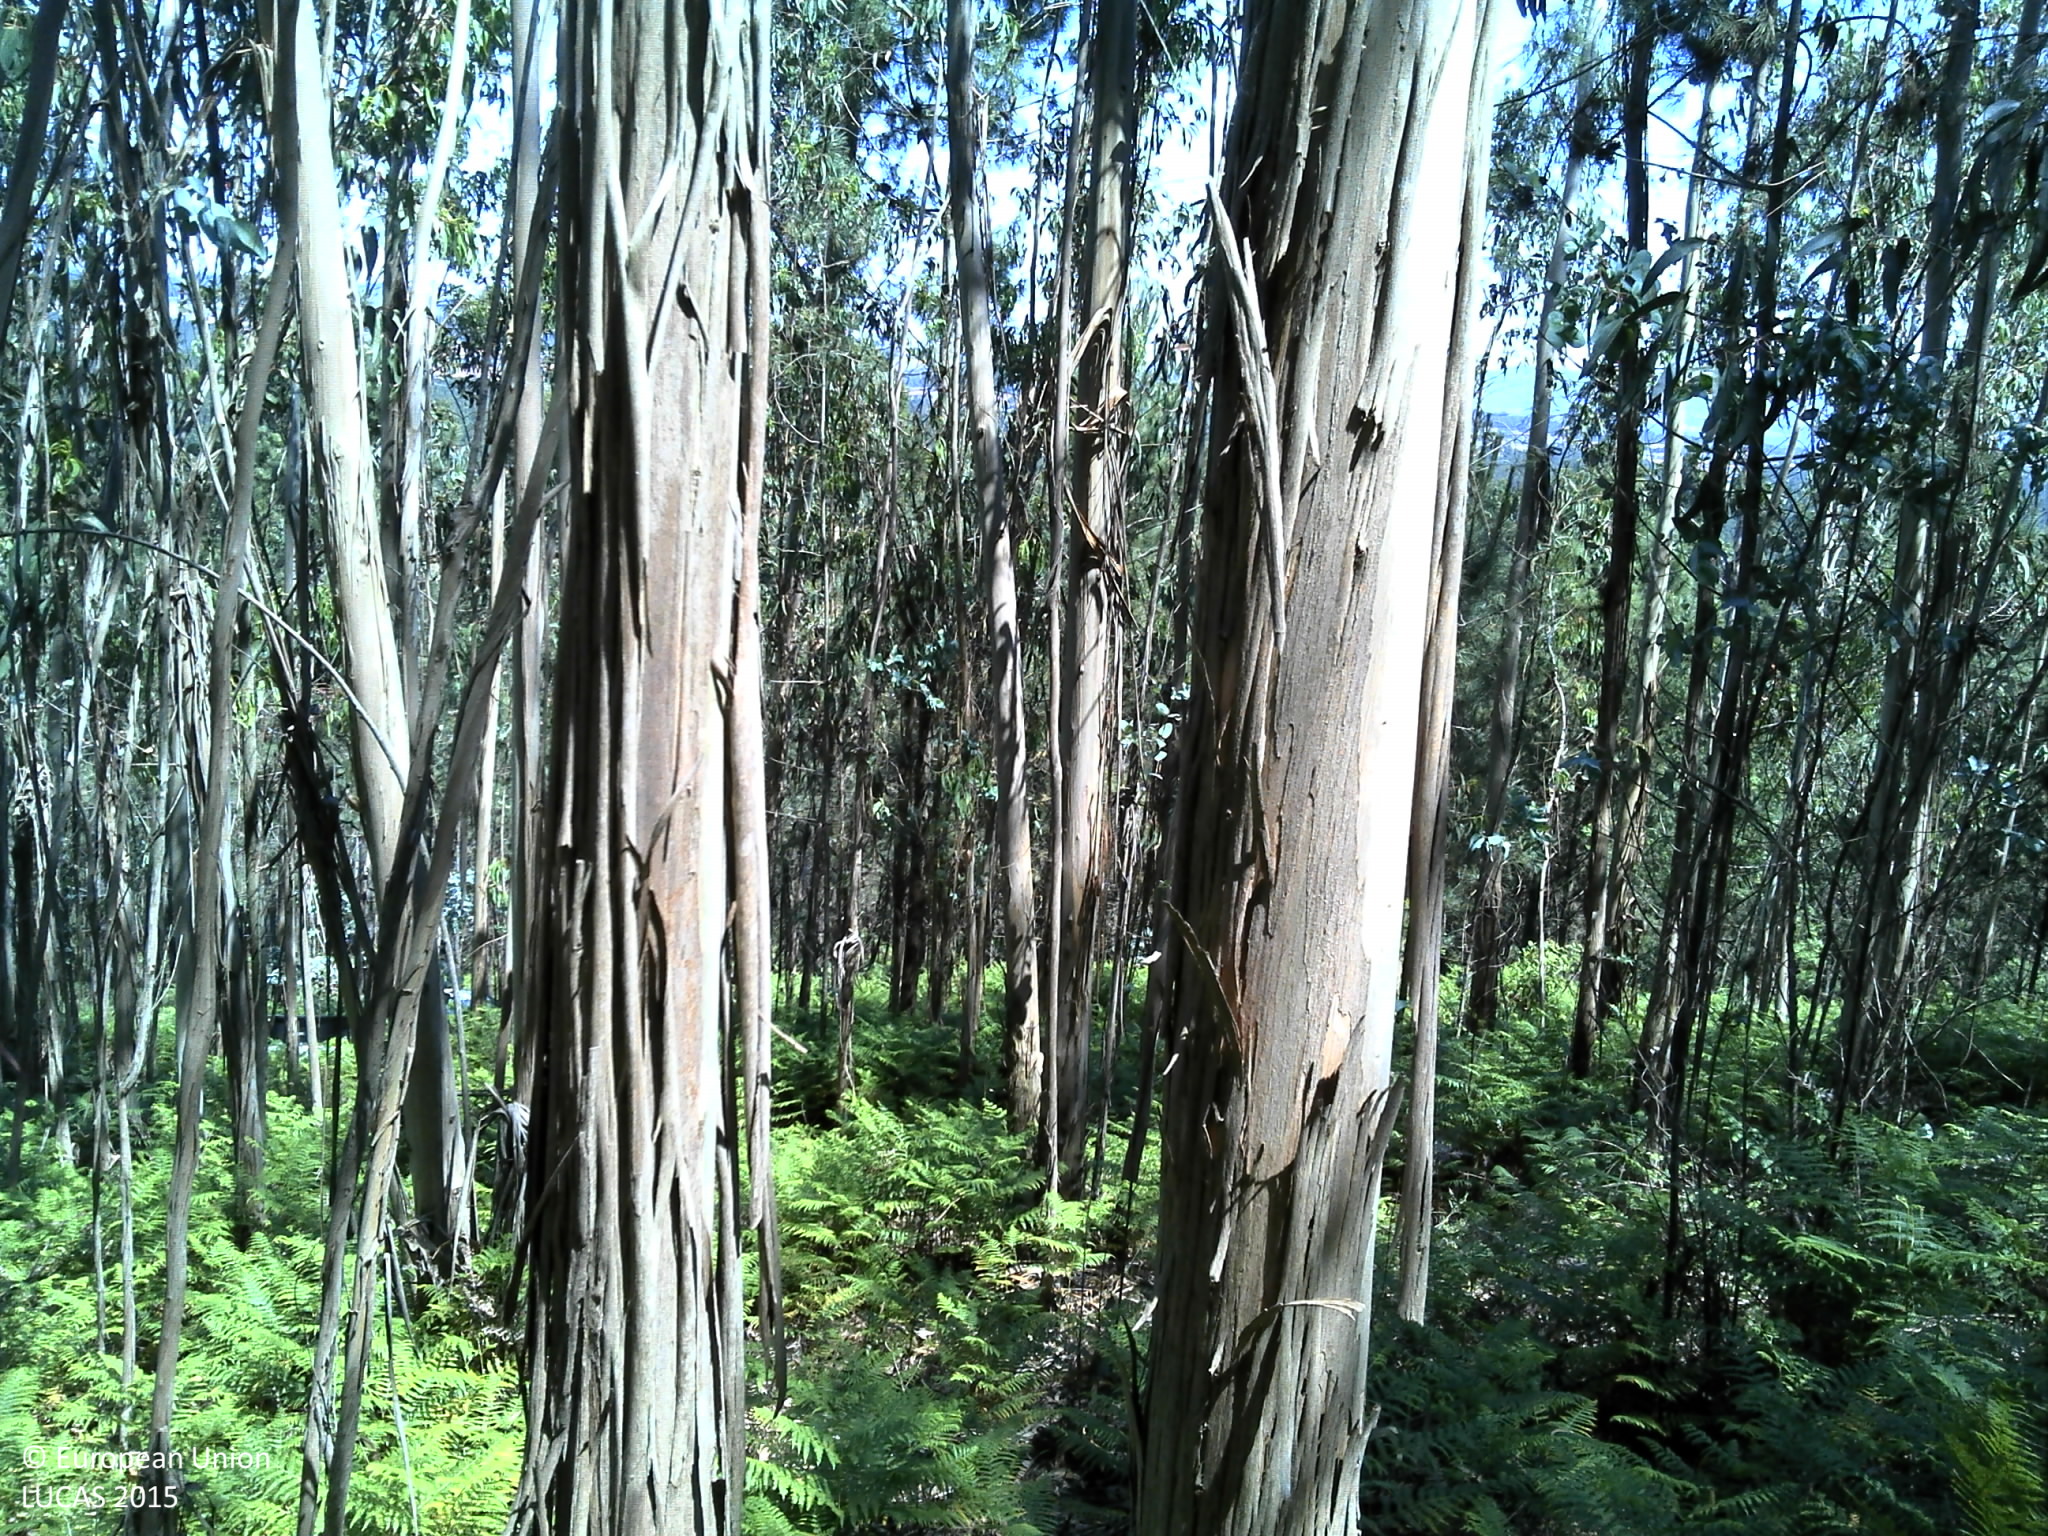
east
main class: Woodland
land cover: Broadleaved woodland
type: exotic forest
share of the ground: 25 - 50 %
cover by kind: broadleaved forest trees 50 %, shrubs 30 %, unconsolidated bare surface 20 %
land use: Forestry
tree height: > 5 m
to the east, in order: Broadleaved woodland; Tracks; Pine dominated coniferous woodland; Tracks; Other fruit trees and berries
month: May
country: PT
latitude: 41.3698
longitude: -8.6282
